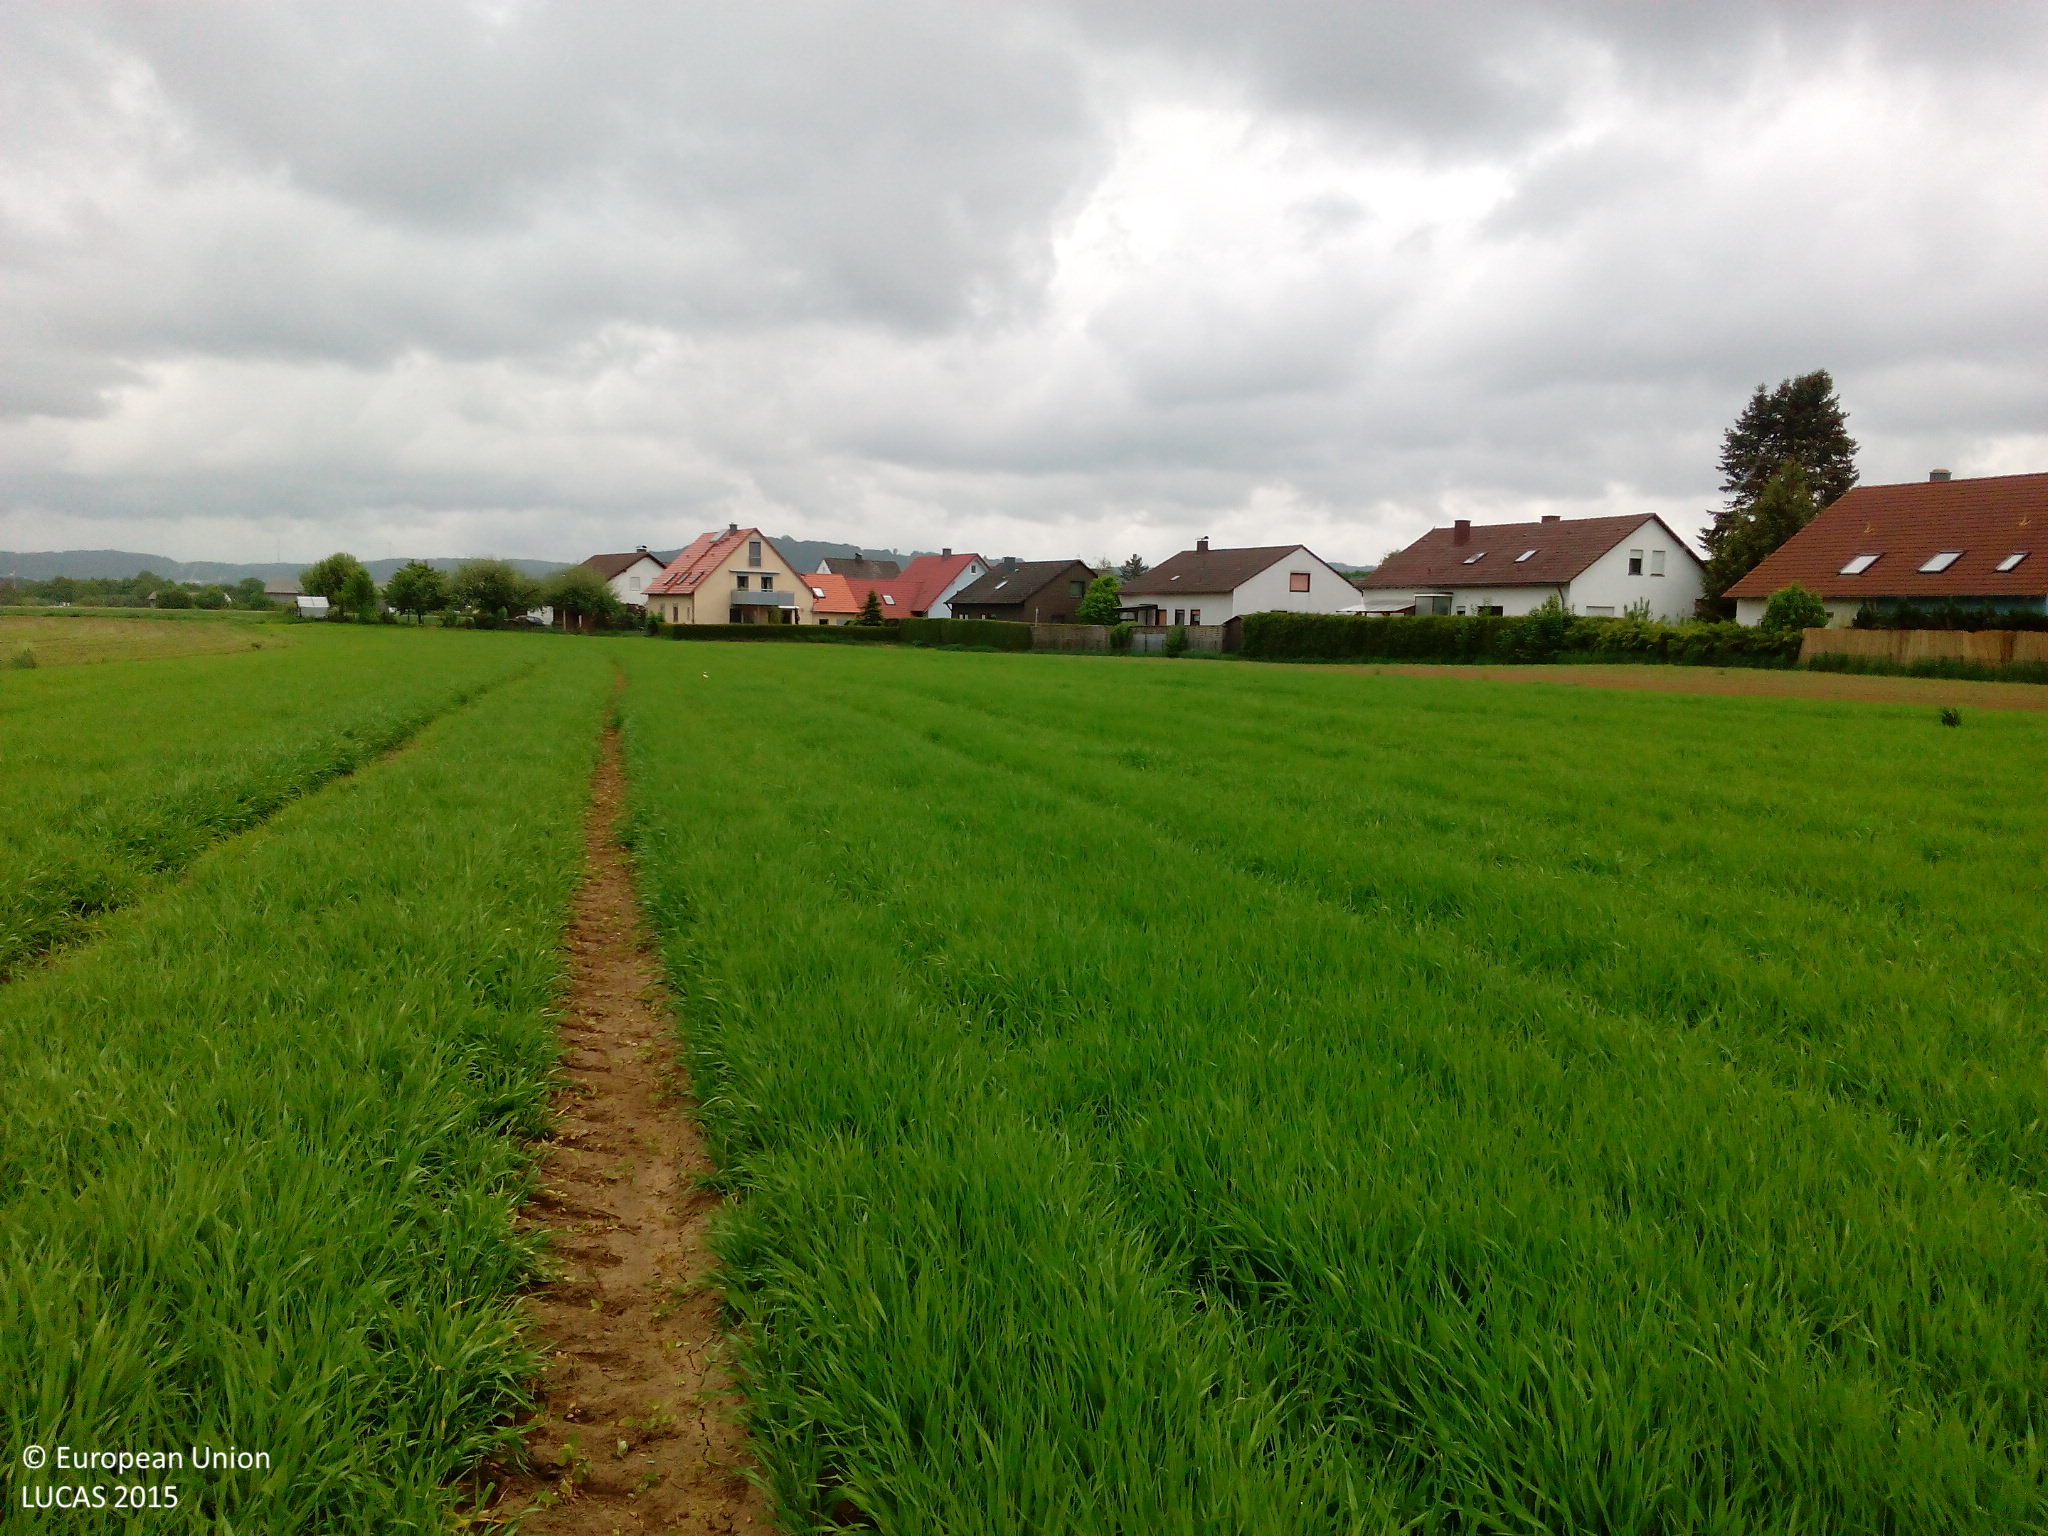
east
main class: Cropland
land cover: Barley
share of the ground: > 75 %
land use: Agriculture (excluding fallow land and kitchen gardens)
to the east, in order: Barley; Grass margins; Other bare soil; Artificial constructions in urban areas; Managed hedges; Grassland without tree/shrub cover
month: May
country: DE
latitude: 49.2937
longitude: 11.4433
